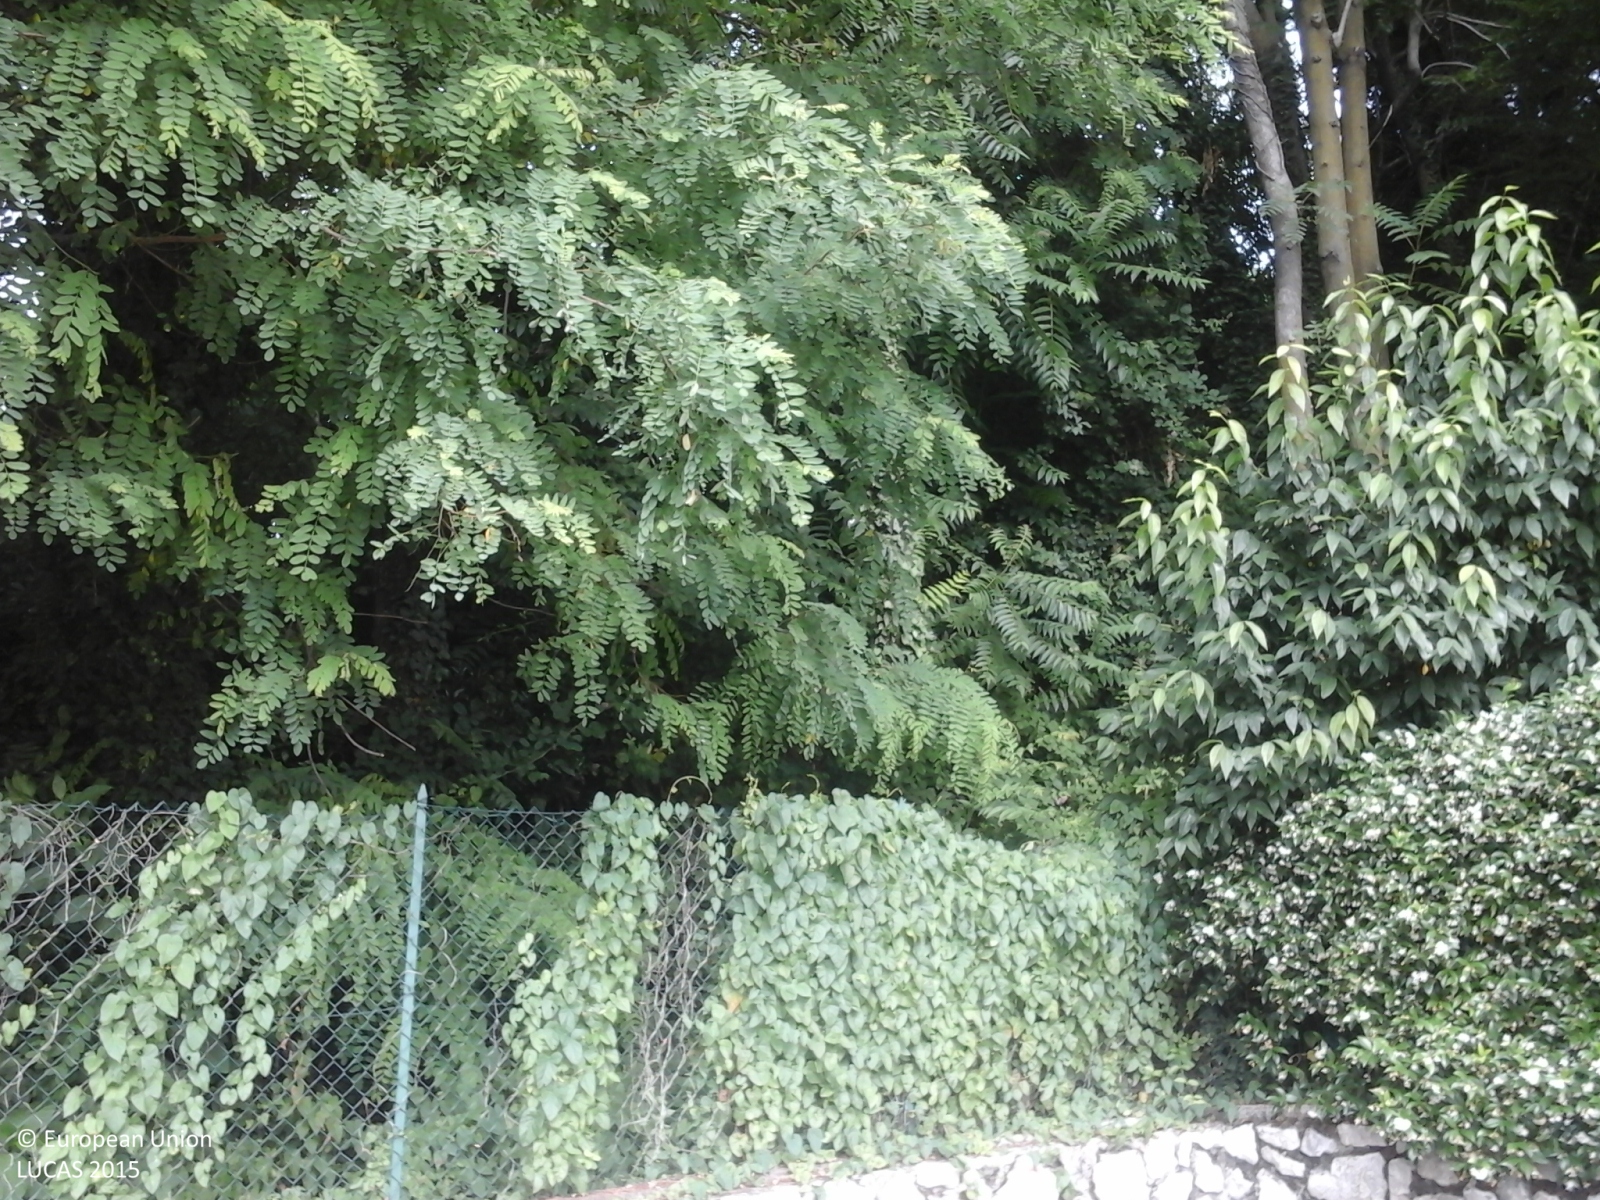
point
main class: Woodland
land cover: Broadleaved woodland
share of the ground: > 75 %
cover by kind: broadleaved forest trees 100 %
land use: Residential
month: June
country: IT
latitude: 45.7097
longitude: 11.5262
